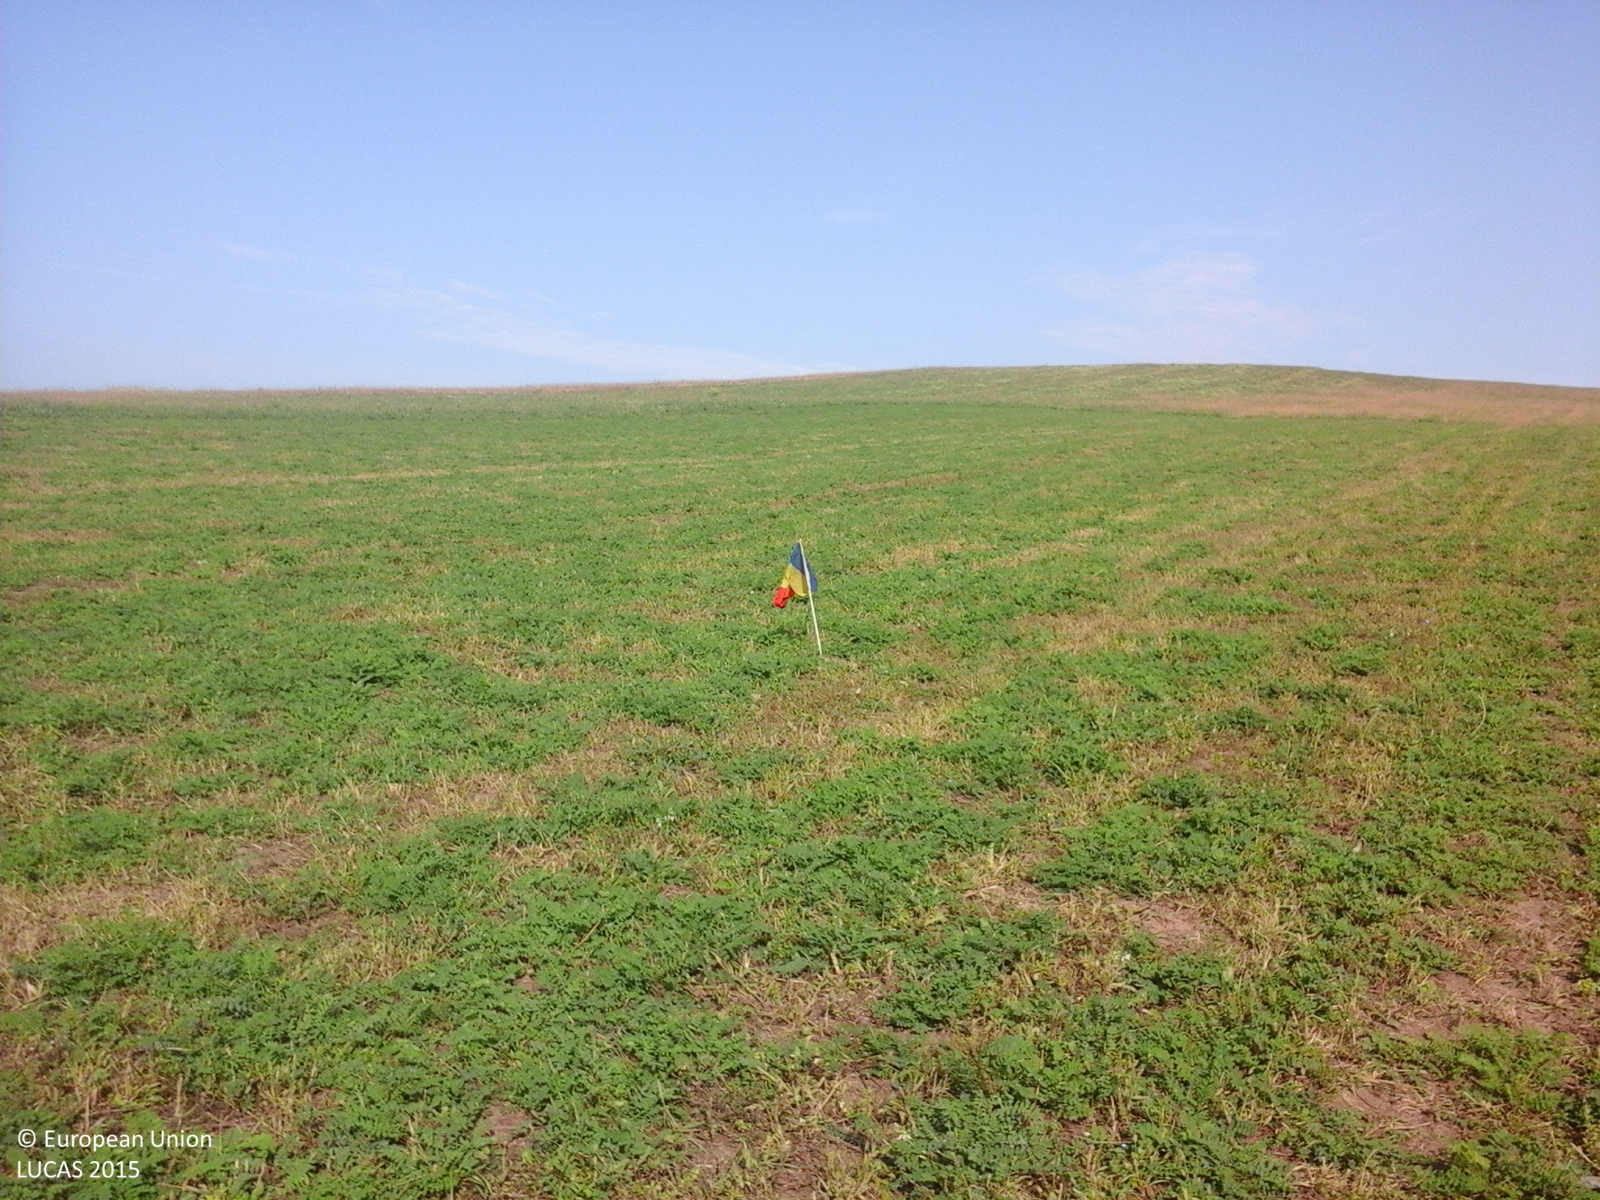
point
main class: Grassland
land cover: Grassland without tree/shrub cover
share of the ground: > 75 %
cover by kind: herbaceous plants 100 %
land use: Agriculture (excluding fallow land and kitchen gardens)
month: October
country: RO
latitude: 46.6793
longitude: 24.3211
